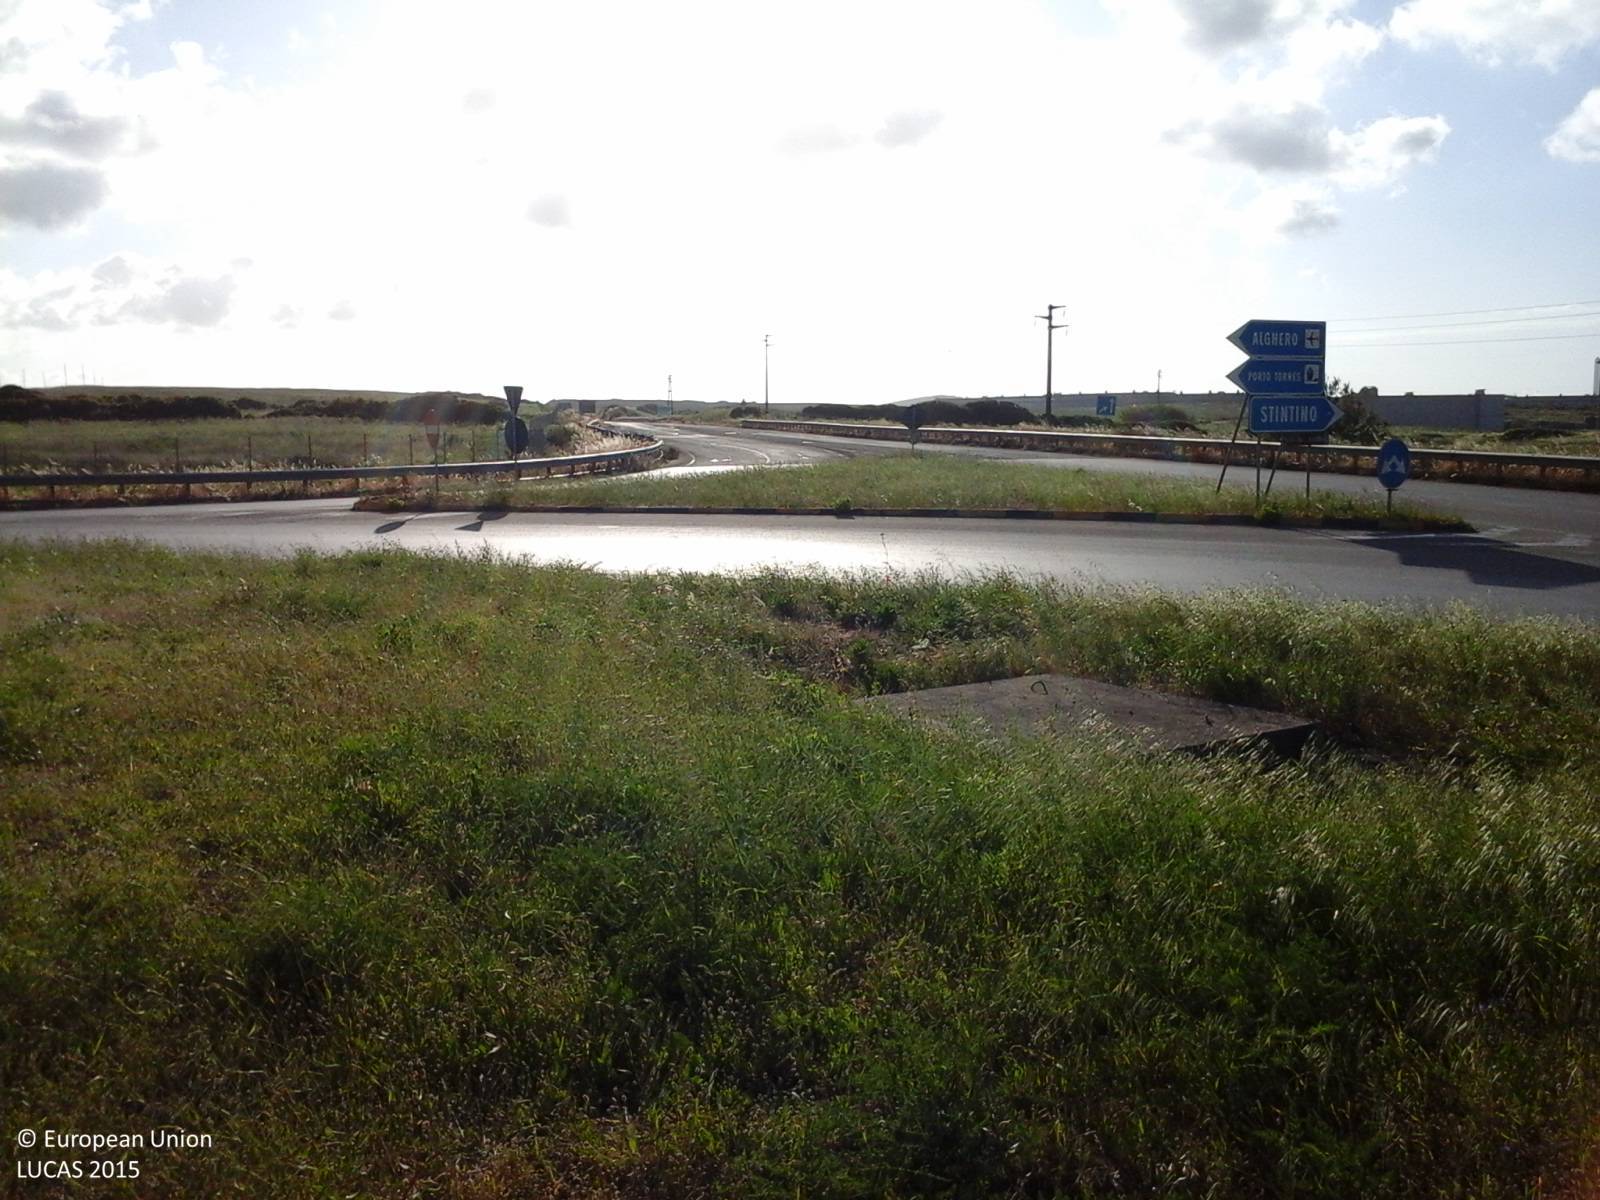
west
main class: Grassland
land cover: Grassland without tree/shrub cover
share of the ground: > 75 %
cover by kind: herbaceous plants 100 %
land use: Road transport
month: May
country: IT
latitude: 40.8147
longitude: 8.3598
